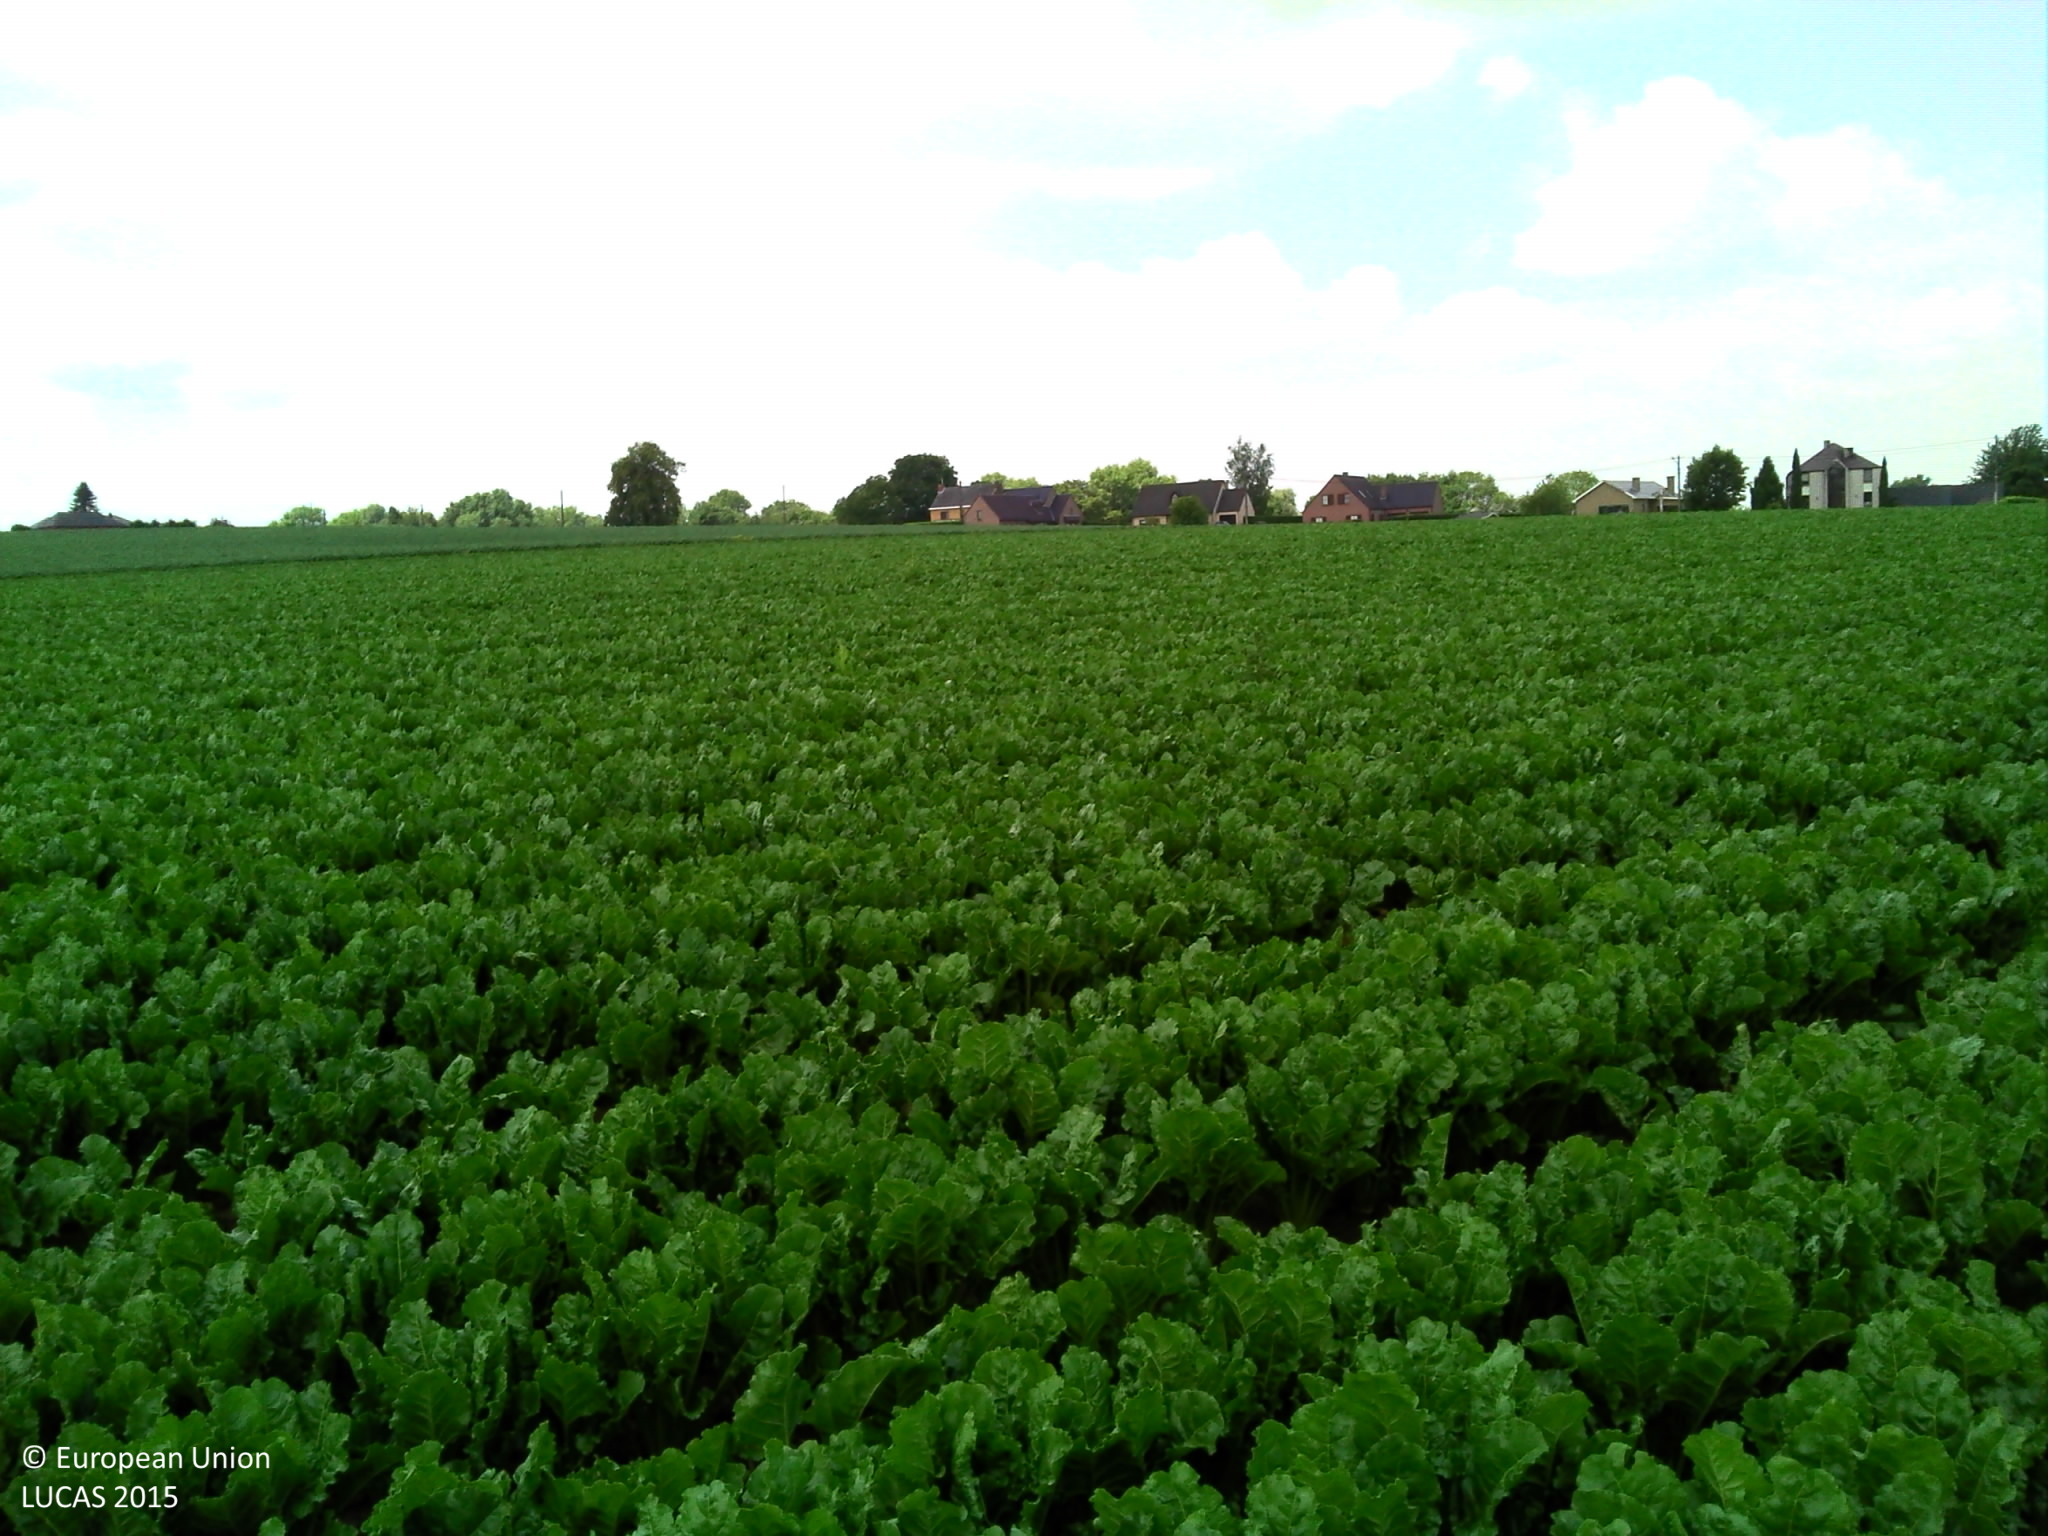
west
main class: Cropland
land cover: Sugar beet
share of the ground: > 75 %
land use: Agriculture (excluding fallow land and kitchen gardens)
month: June
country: BE
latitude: 50.6086
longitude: 3.7616
